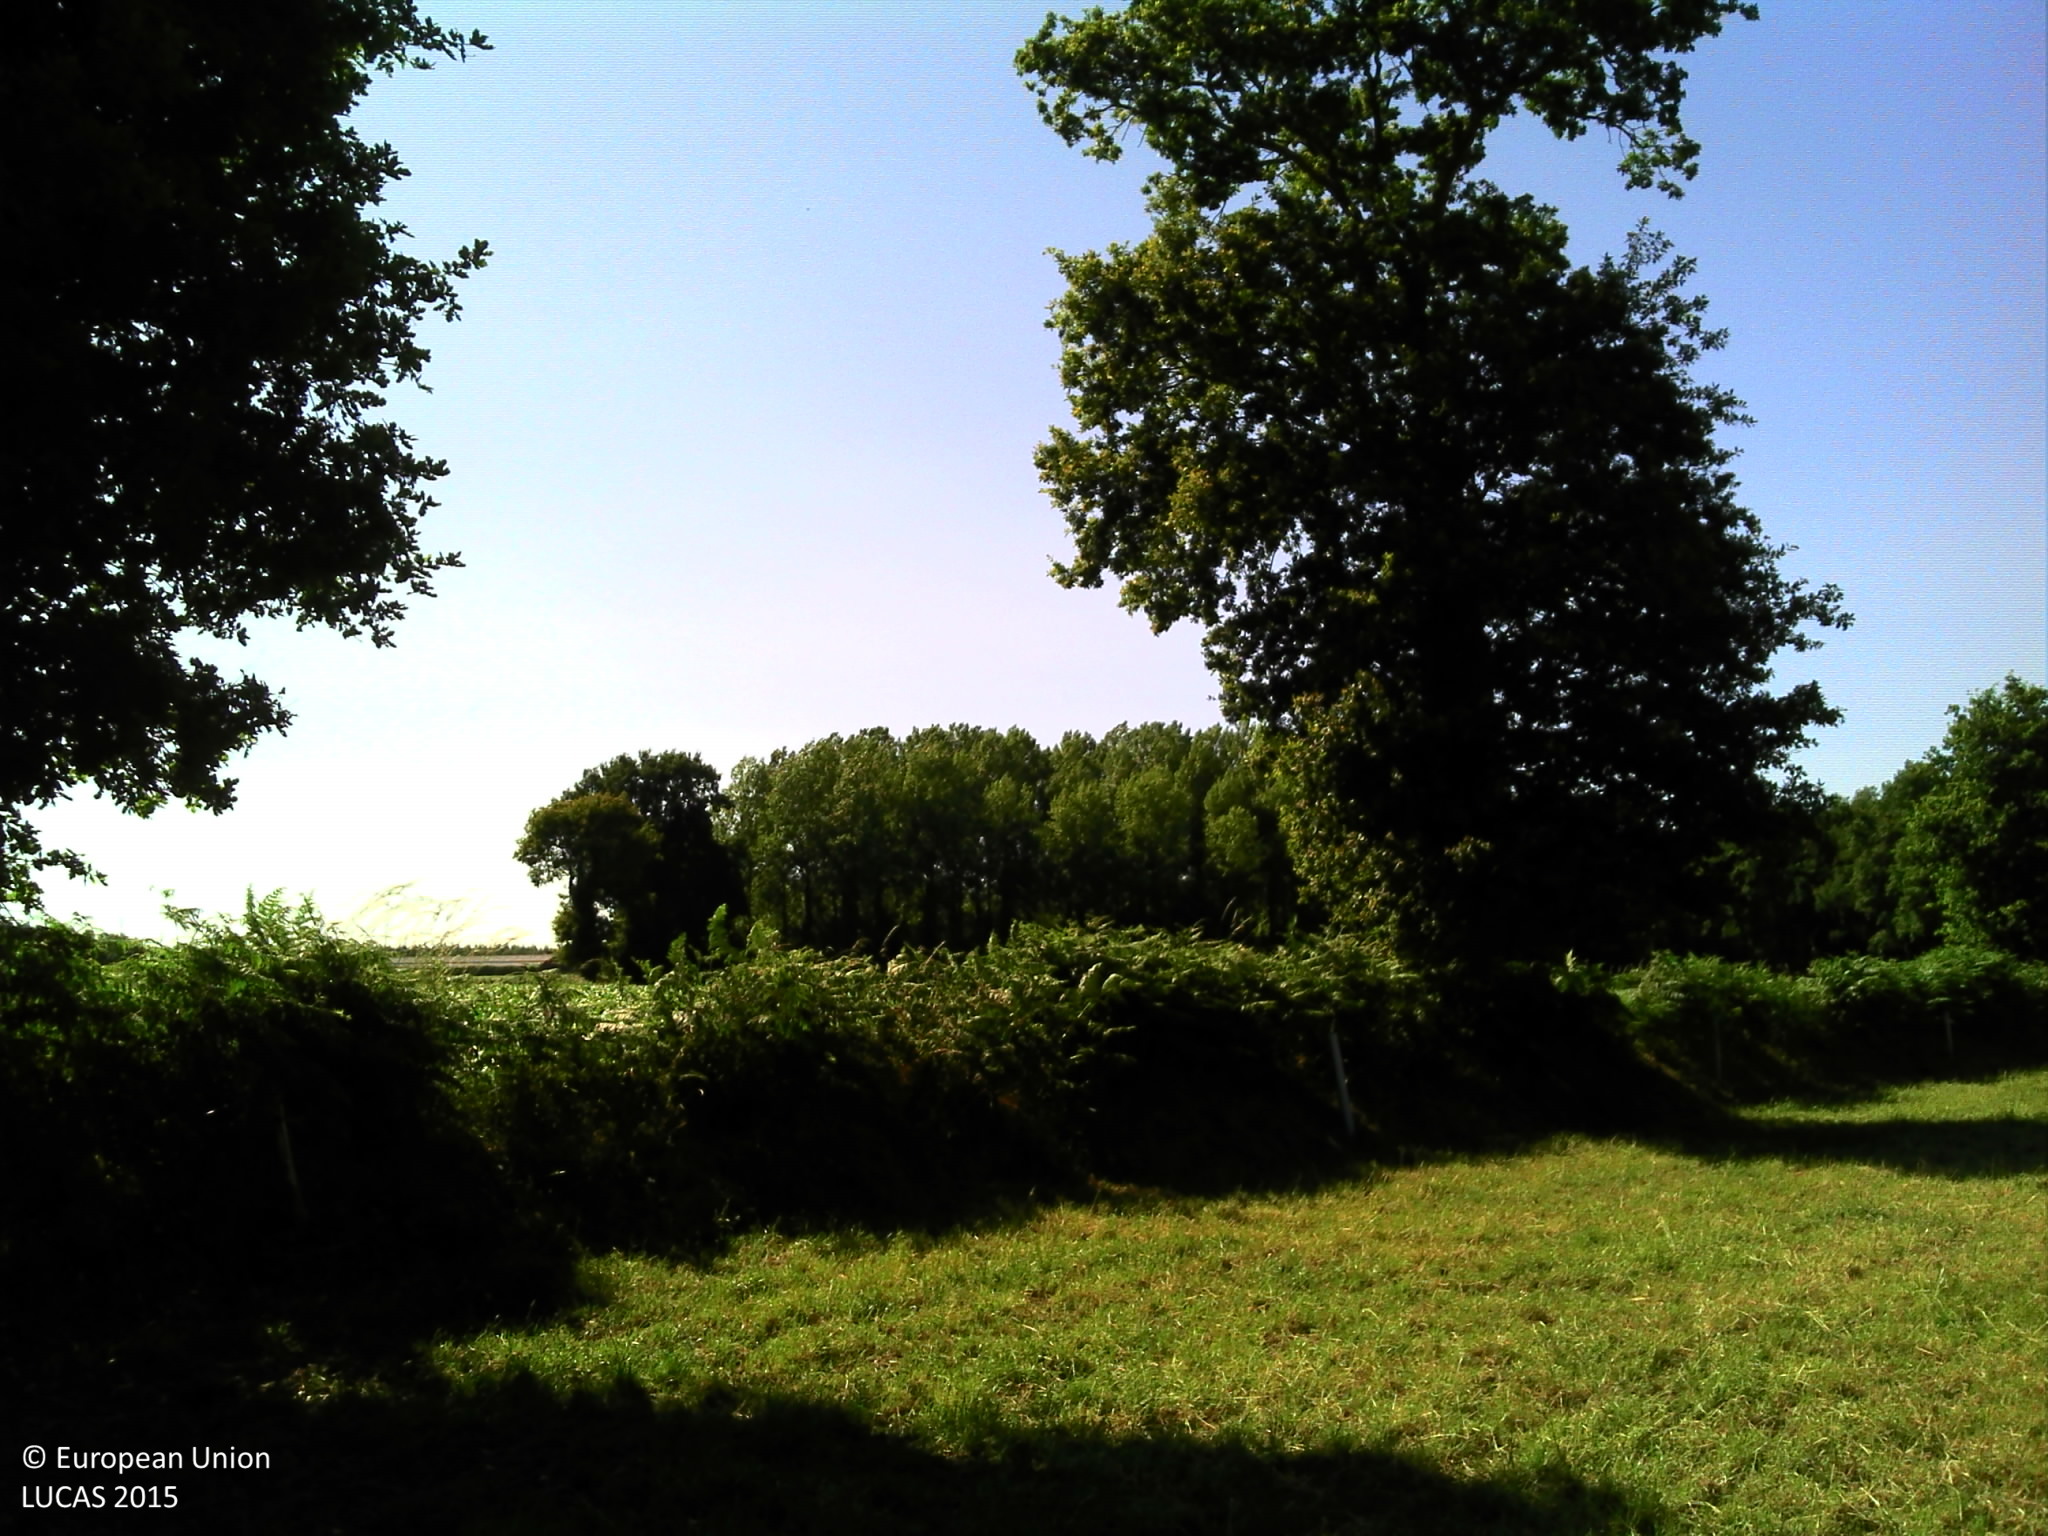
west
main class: Grassland
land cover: Grassland without tree/shrub cover
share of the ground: > 75 %
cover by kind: herbaceous plants 100 %
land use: Agriculture (excluding fallow land and kitchen gardens)
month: July
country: FR
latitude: 48.3865
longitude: -2.1414
